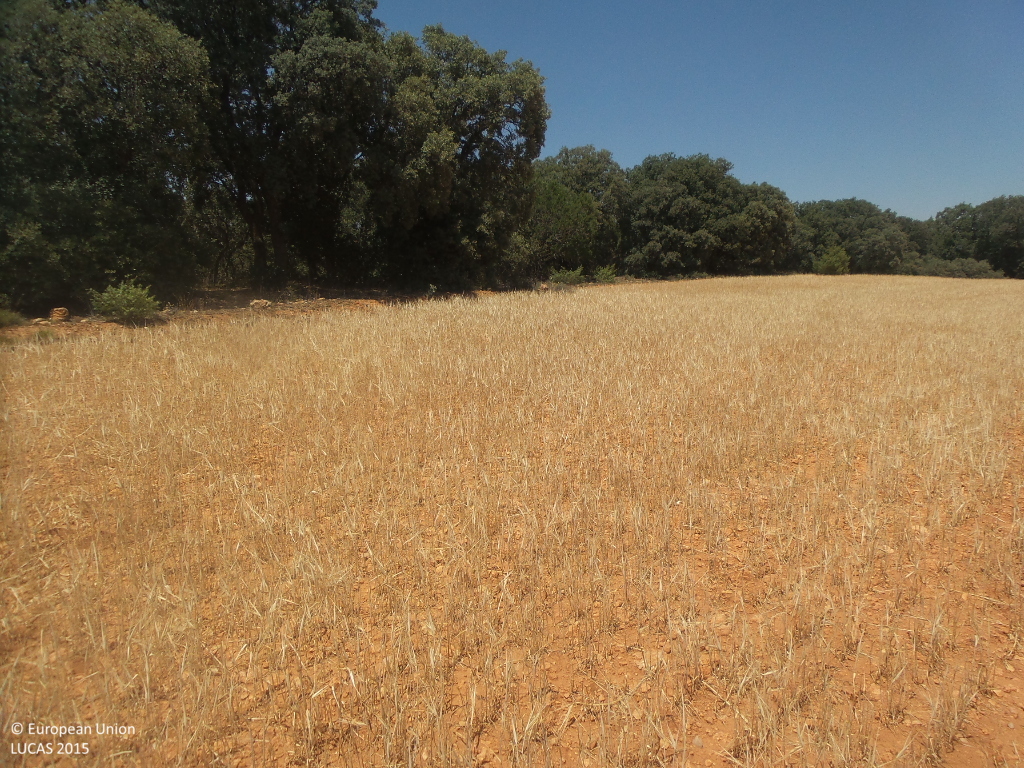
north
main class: Cropland
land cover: Barley
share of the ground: 50 - 75 %
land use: Agriculture (excluding fallow land and kitchen gardens)
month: July
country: ES
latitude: 41.1685
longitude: -2.1738
